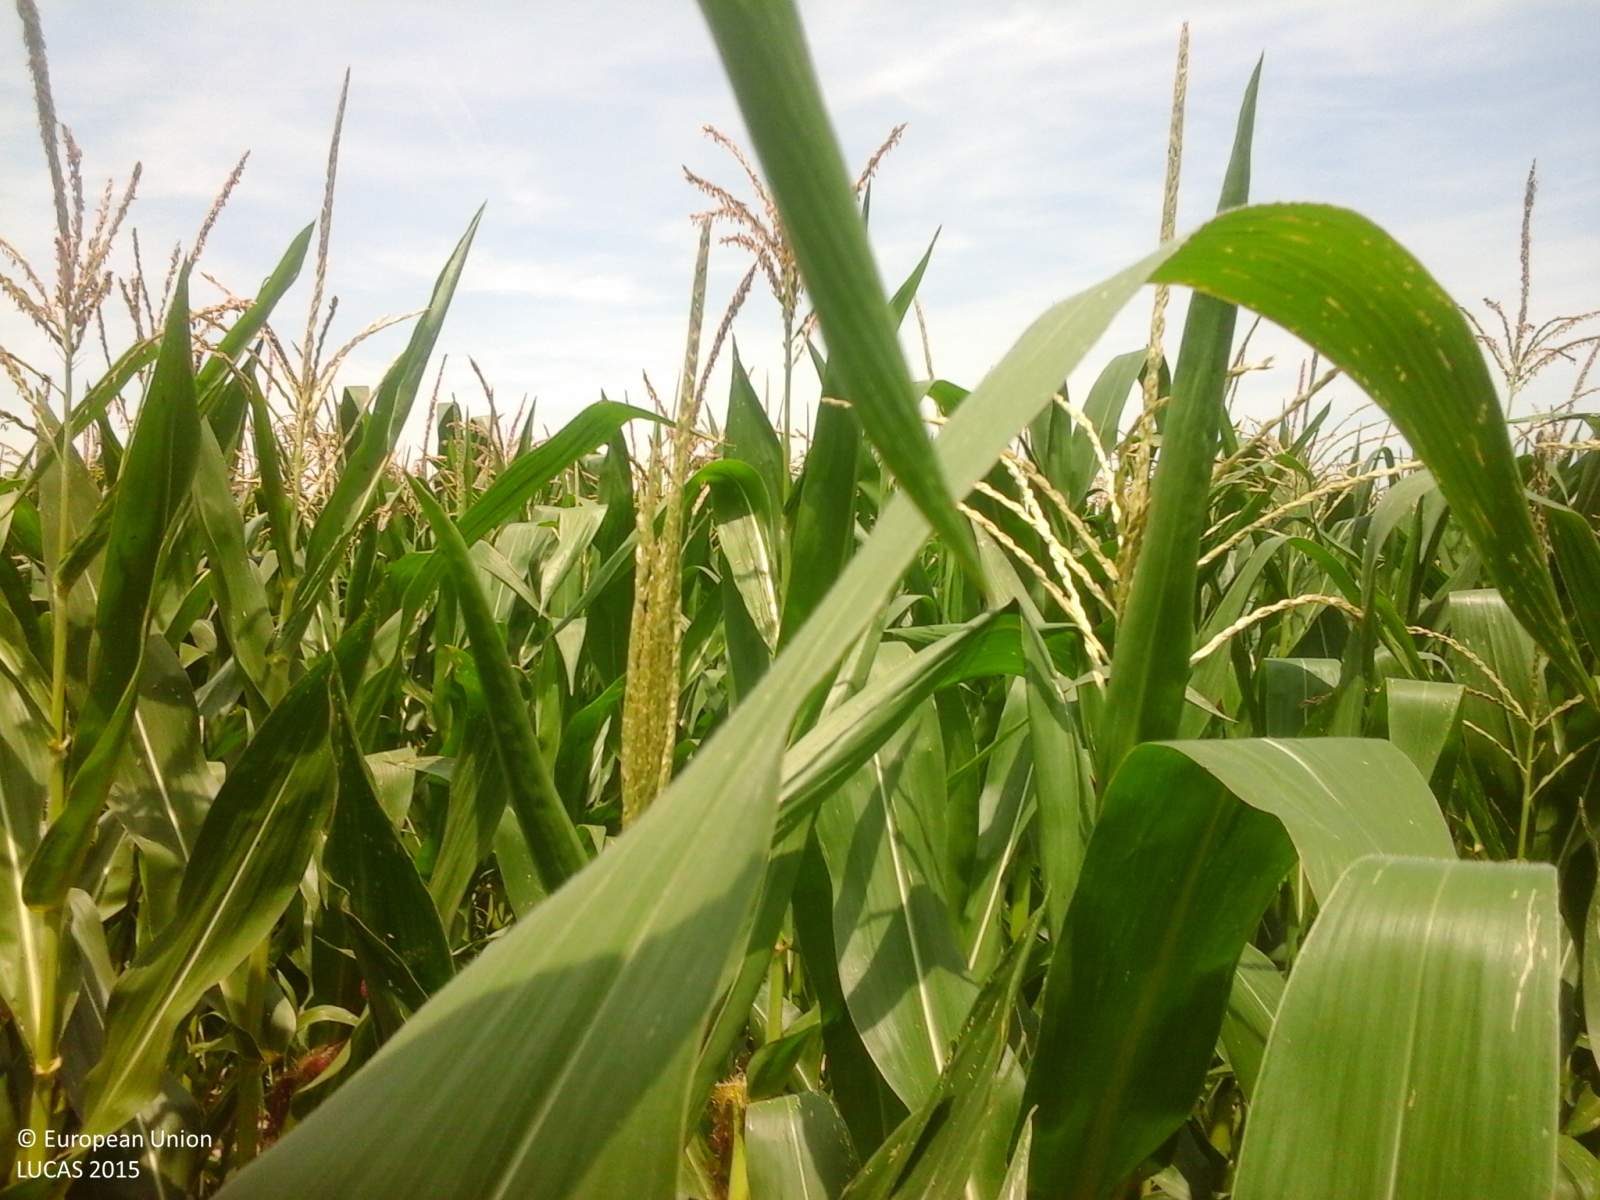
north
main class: Cropland
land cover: Maize
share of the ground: > 75 %
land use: Agriculture (excluding fallow land and kitchen gardens)
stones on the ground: < 10 %
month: June
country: IT
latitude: 44.9928
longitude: 8.7973
